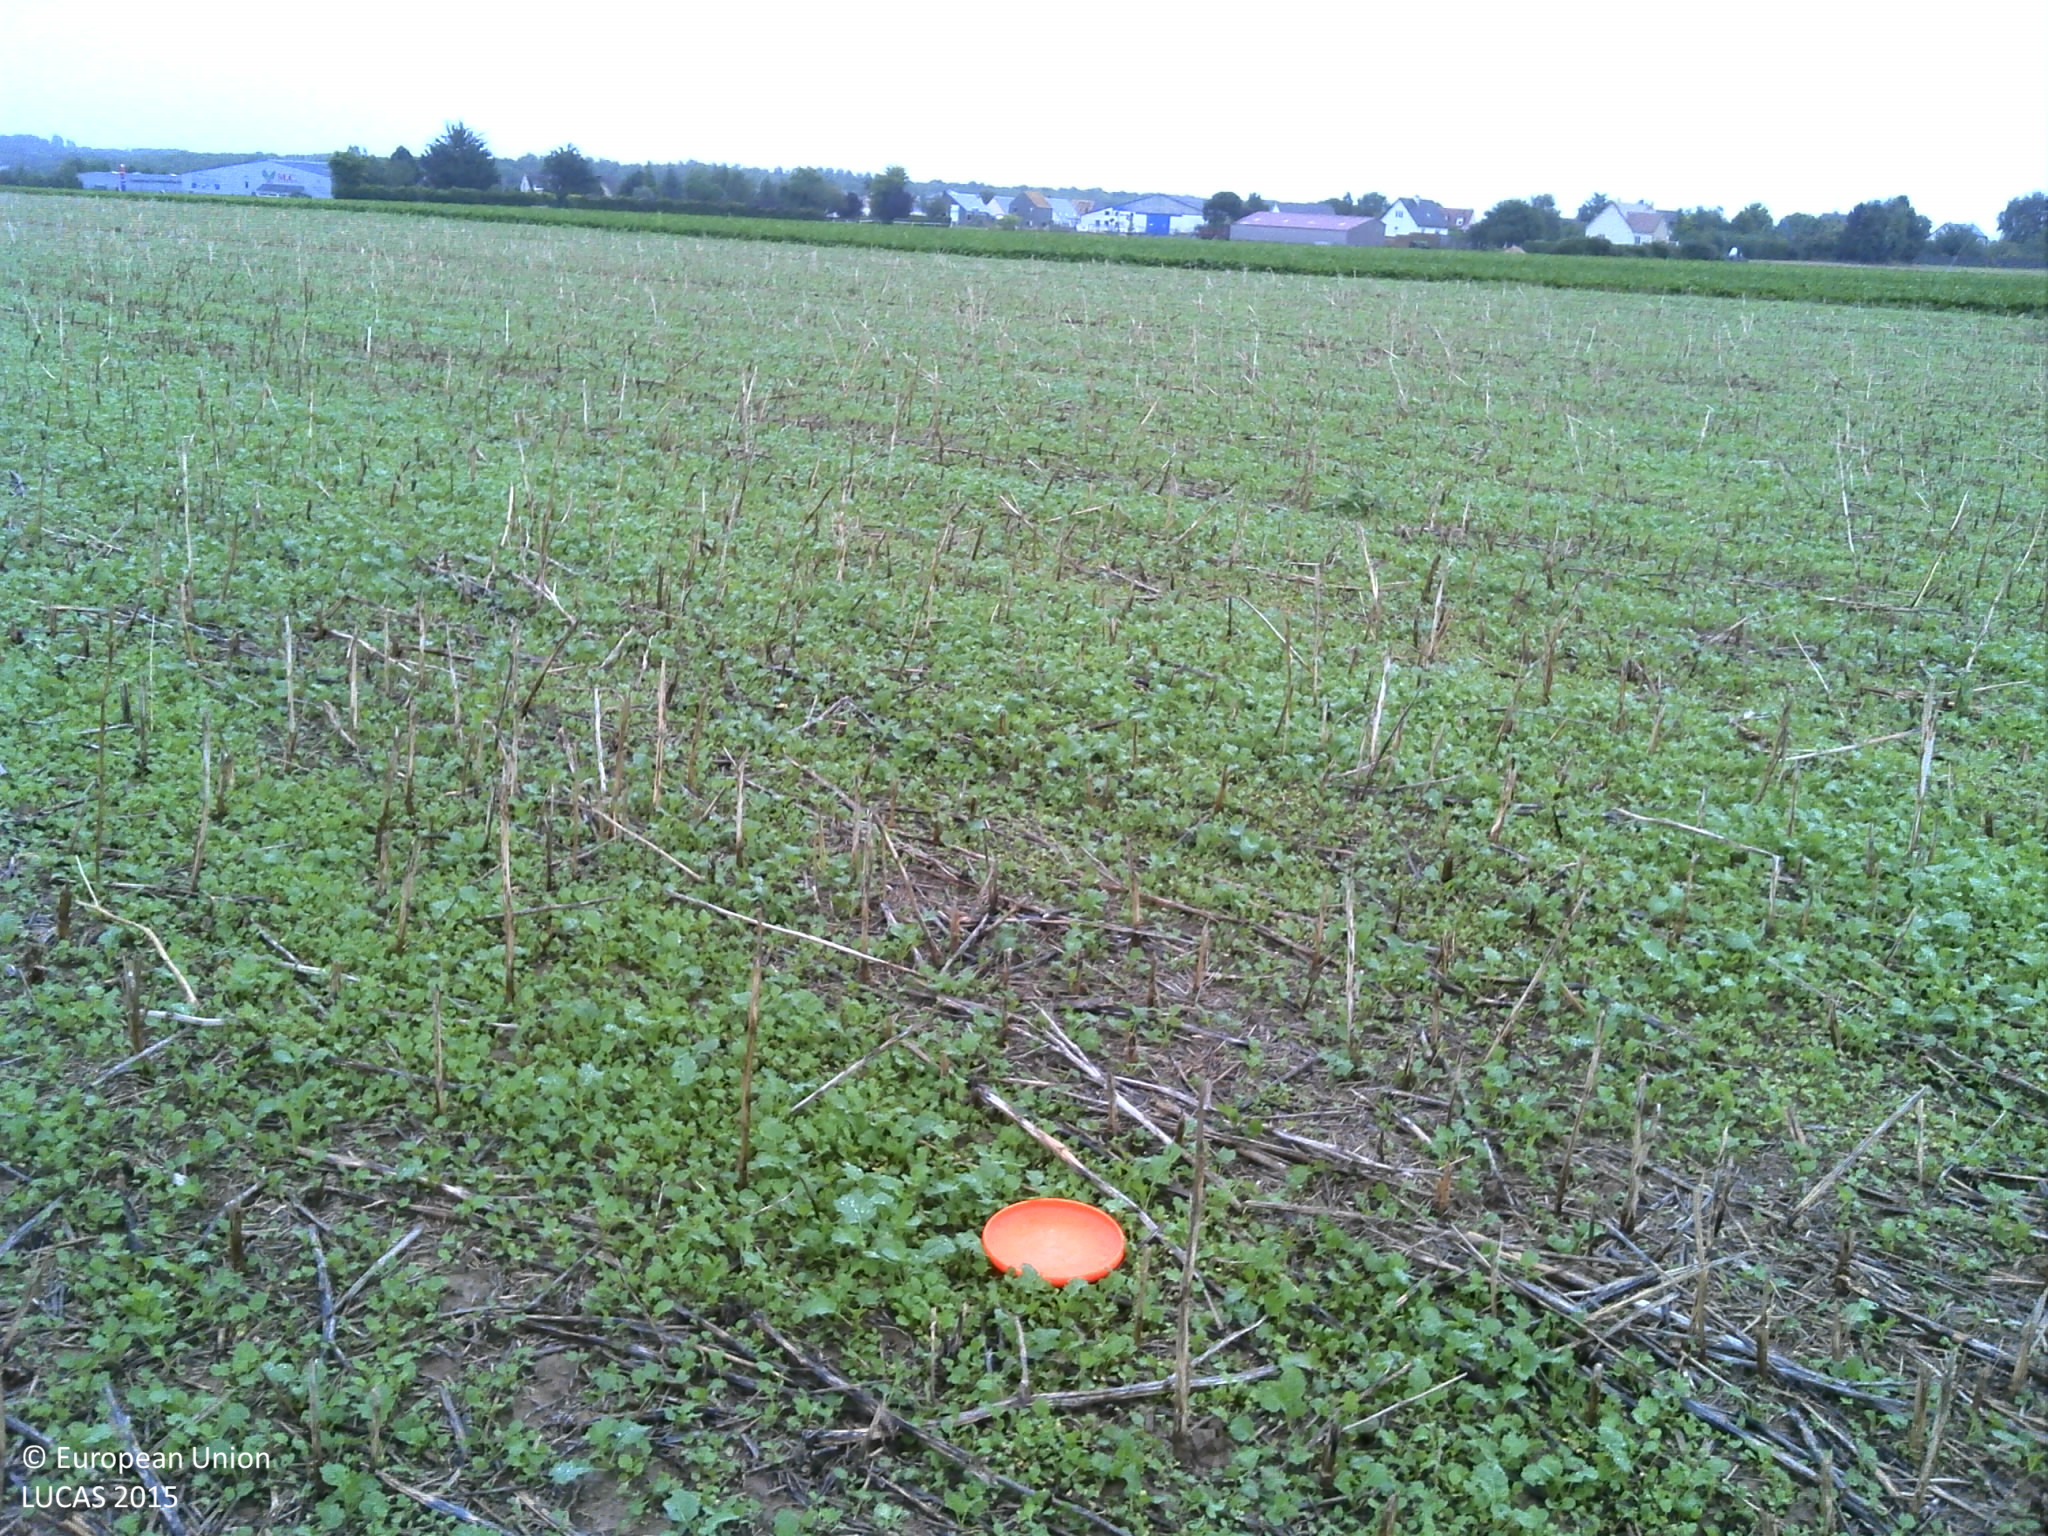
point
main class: Cropland
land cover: Rape and turnip rape
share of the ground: 25 - 50 %
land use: Agriculture (excluding fallow land and kitchen gardens)
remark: Harvested field
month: August
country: FR
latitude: 49.2633
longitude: -0.2993
